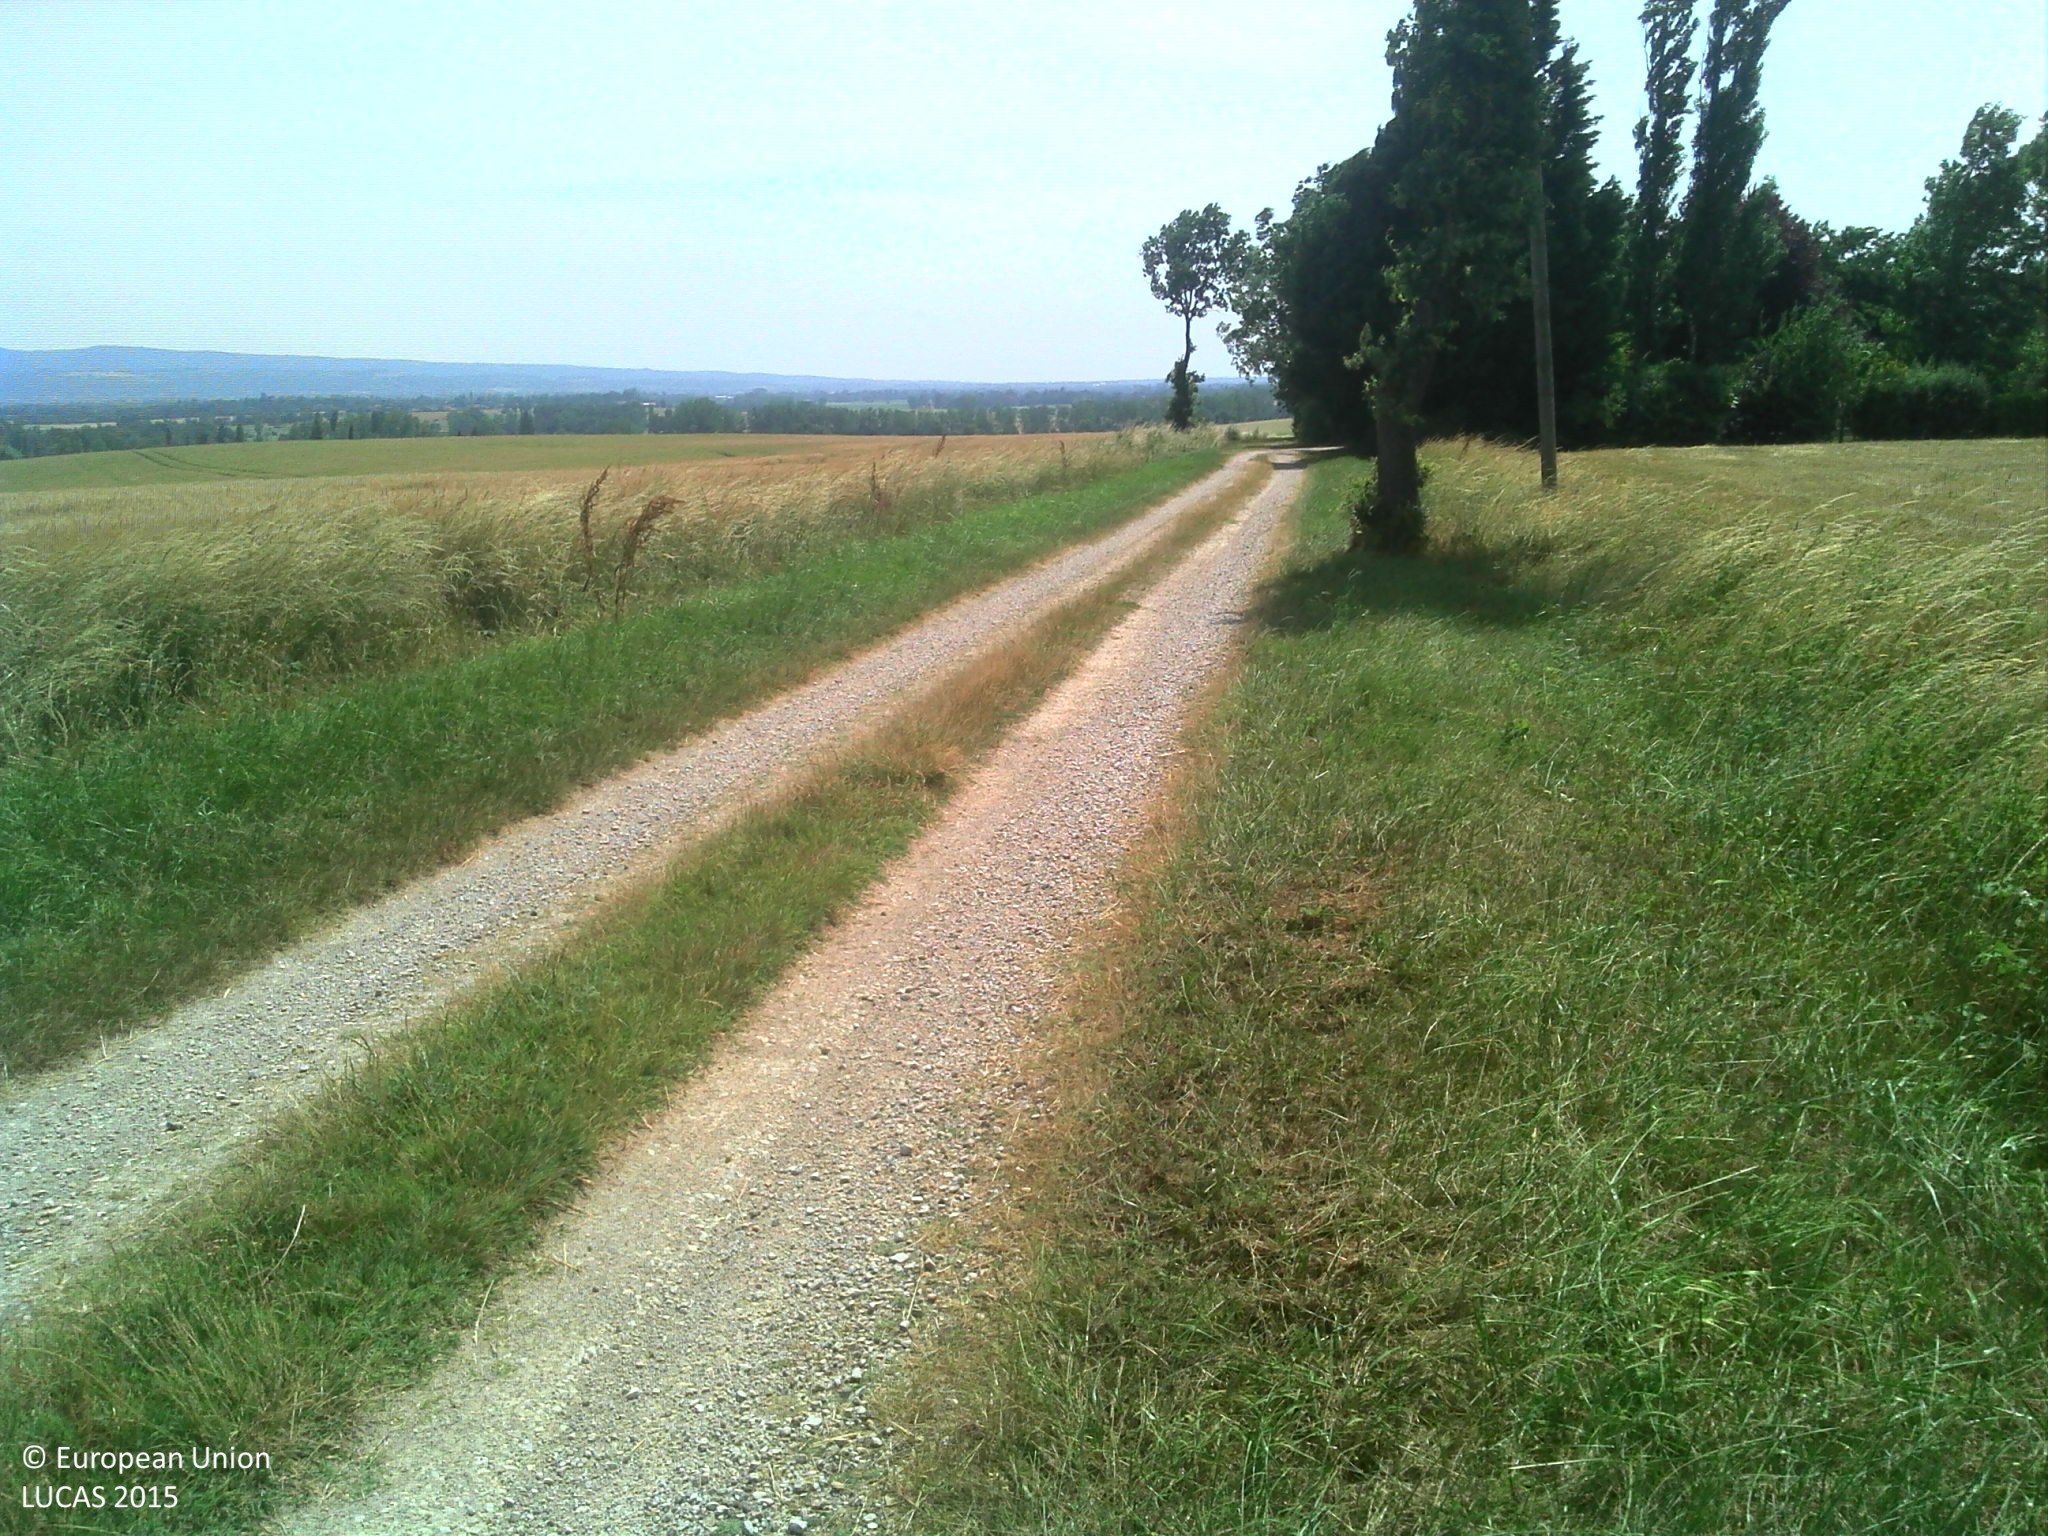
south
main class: Cropland
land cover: Durum wheat
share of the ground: > 75 %
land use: Agriculture (excluding fallow land and kitchen gardens)
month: June
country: FR
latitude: 43.5339
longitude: 1.9990
